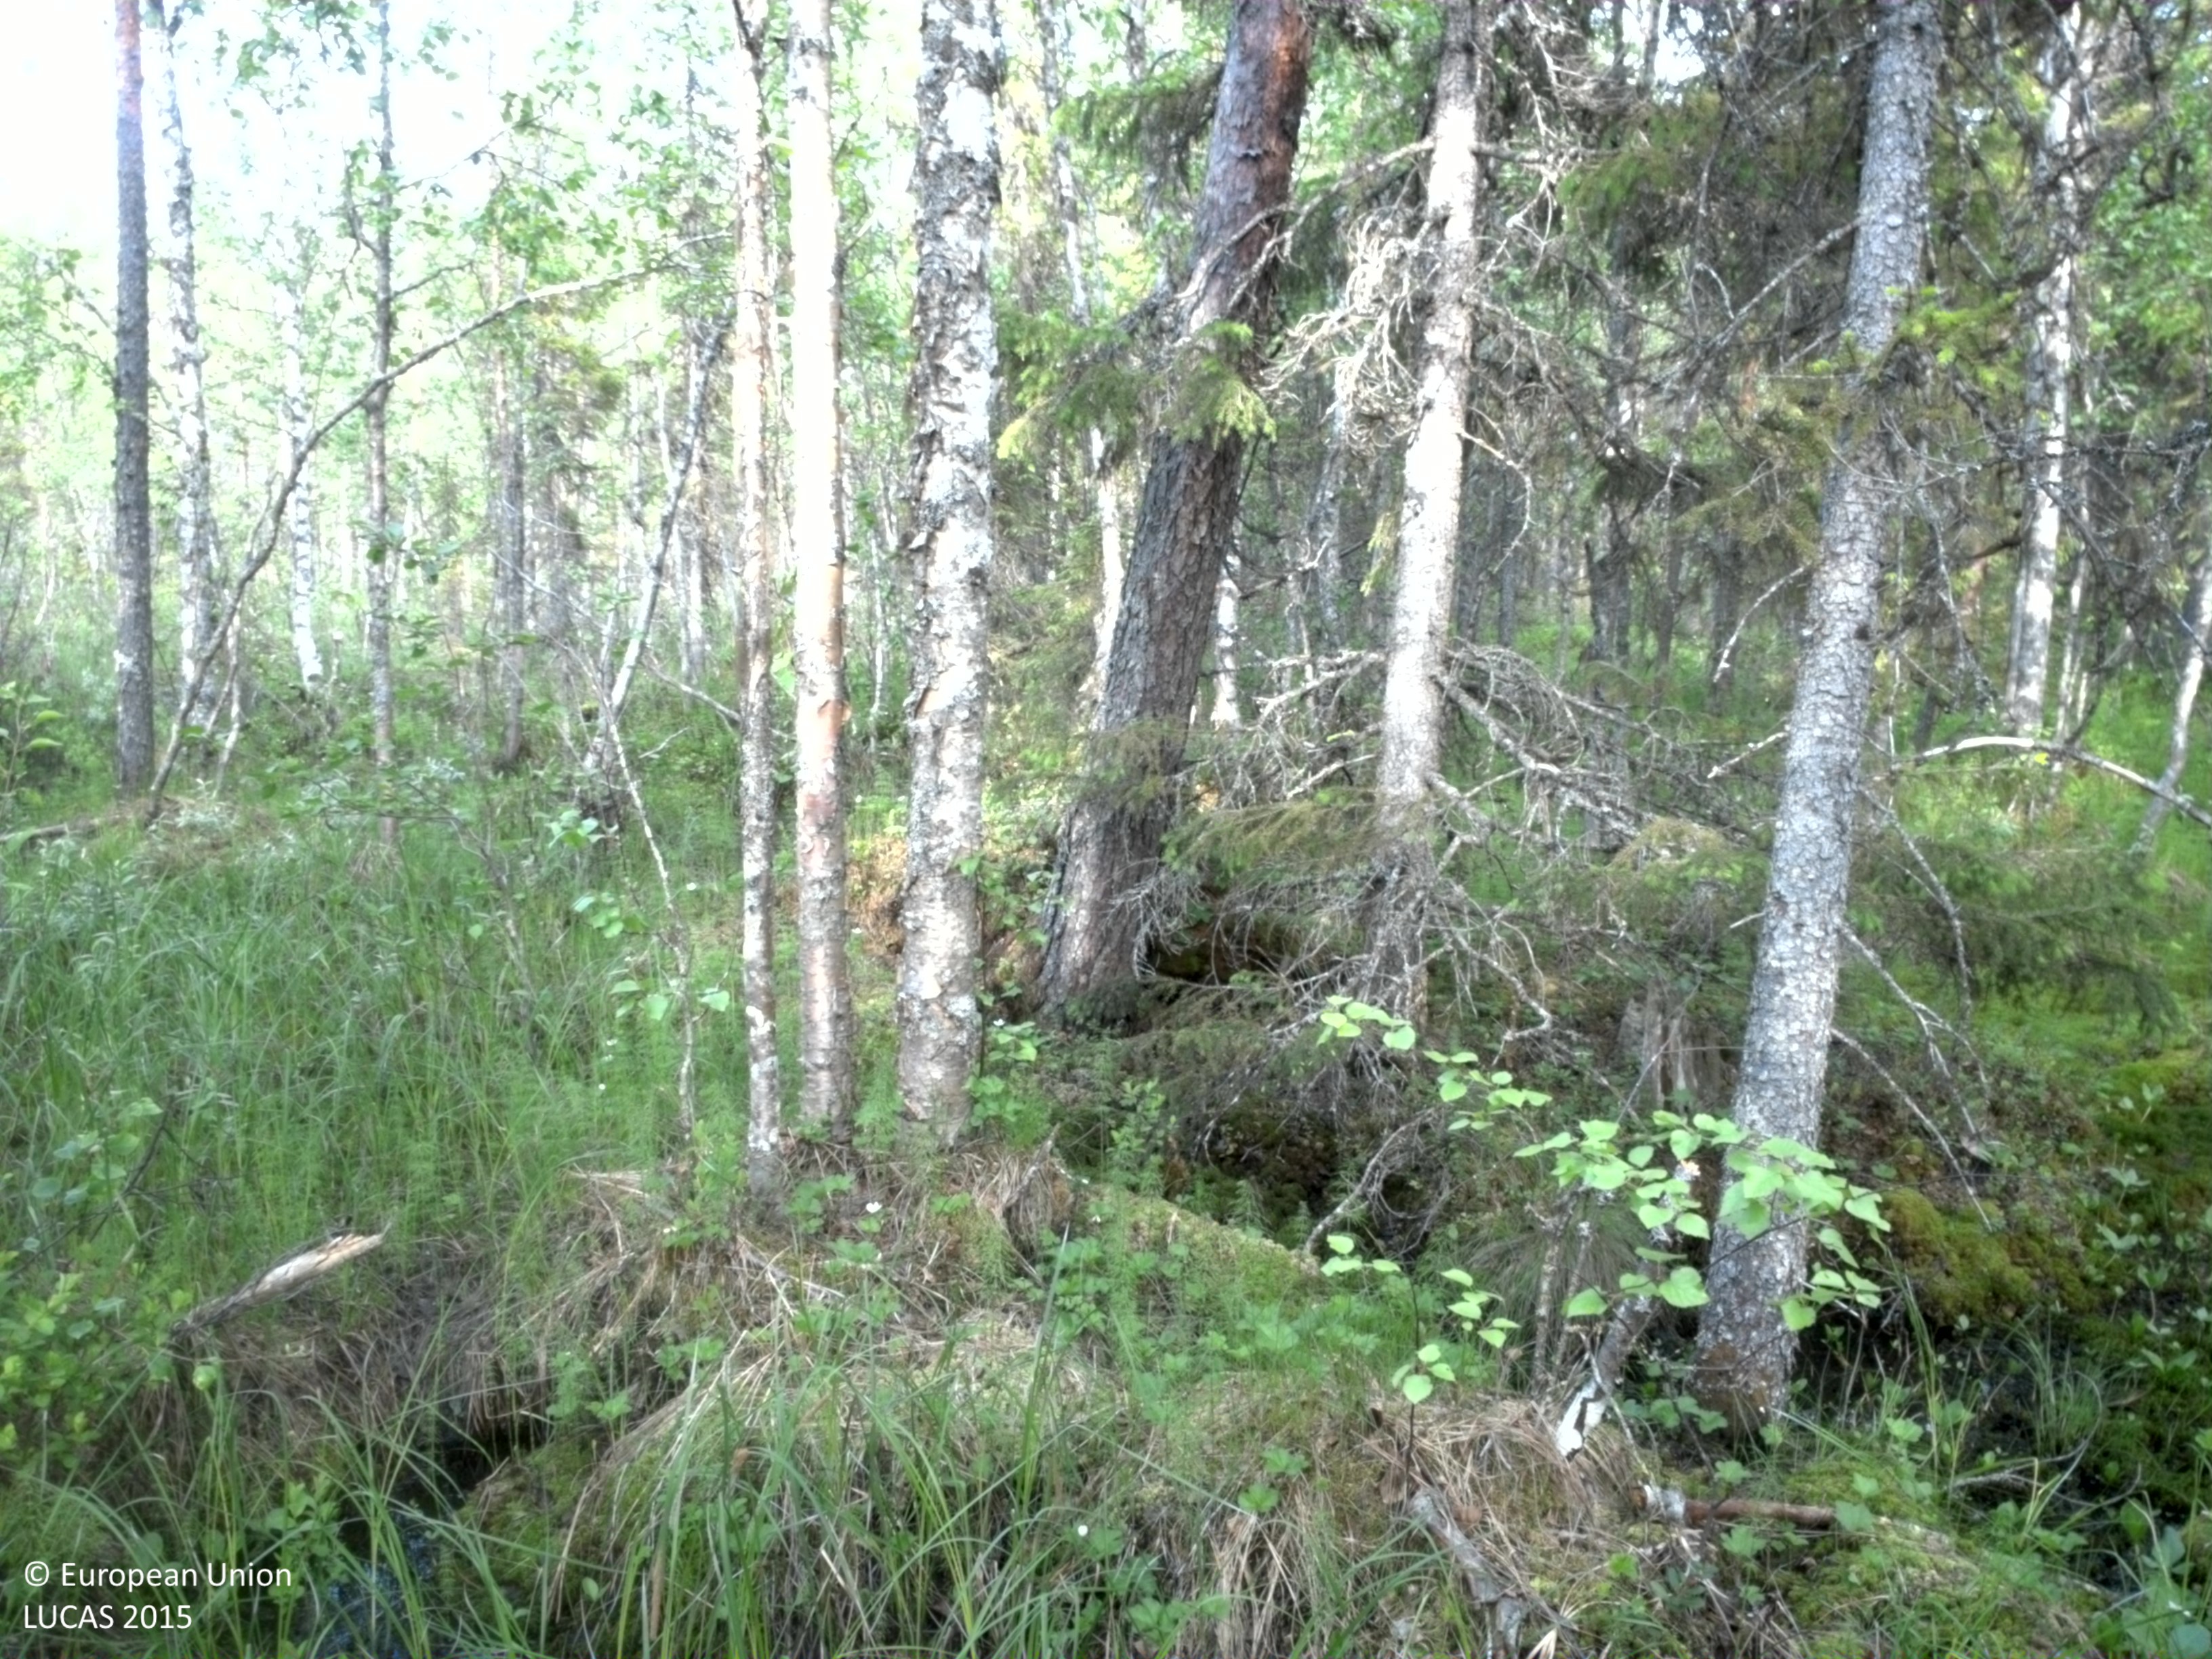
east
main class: Woodland
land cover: Pine dominated mixed woodland
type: mire and swamp forests
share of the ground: 50 - 75 %
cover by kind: broadleaved forest trees 30 %, coniferous forest trees 25 %, herbaceous plants 20 %, lichens and mosses 10 %, shrubs 5 %
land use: Semi-natural and natural areas not in use
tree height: > 5 m
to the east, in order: Pine dominated mixed woodland; Spruce dominated coniferous woodland; Pine dominated coniferous woodland; Groves; Tracks; Groves; Pine dominated coniferous woodland; Pine dominated mixed woodland; Broadleaved woodland; Pine dominated mixed woodland
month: June
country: SE
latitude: 66.2488
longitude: 22.7719
